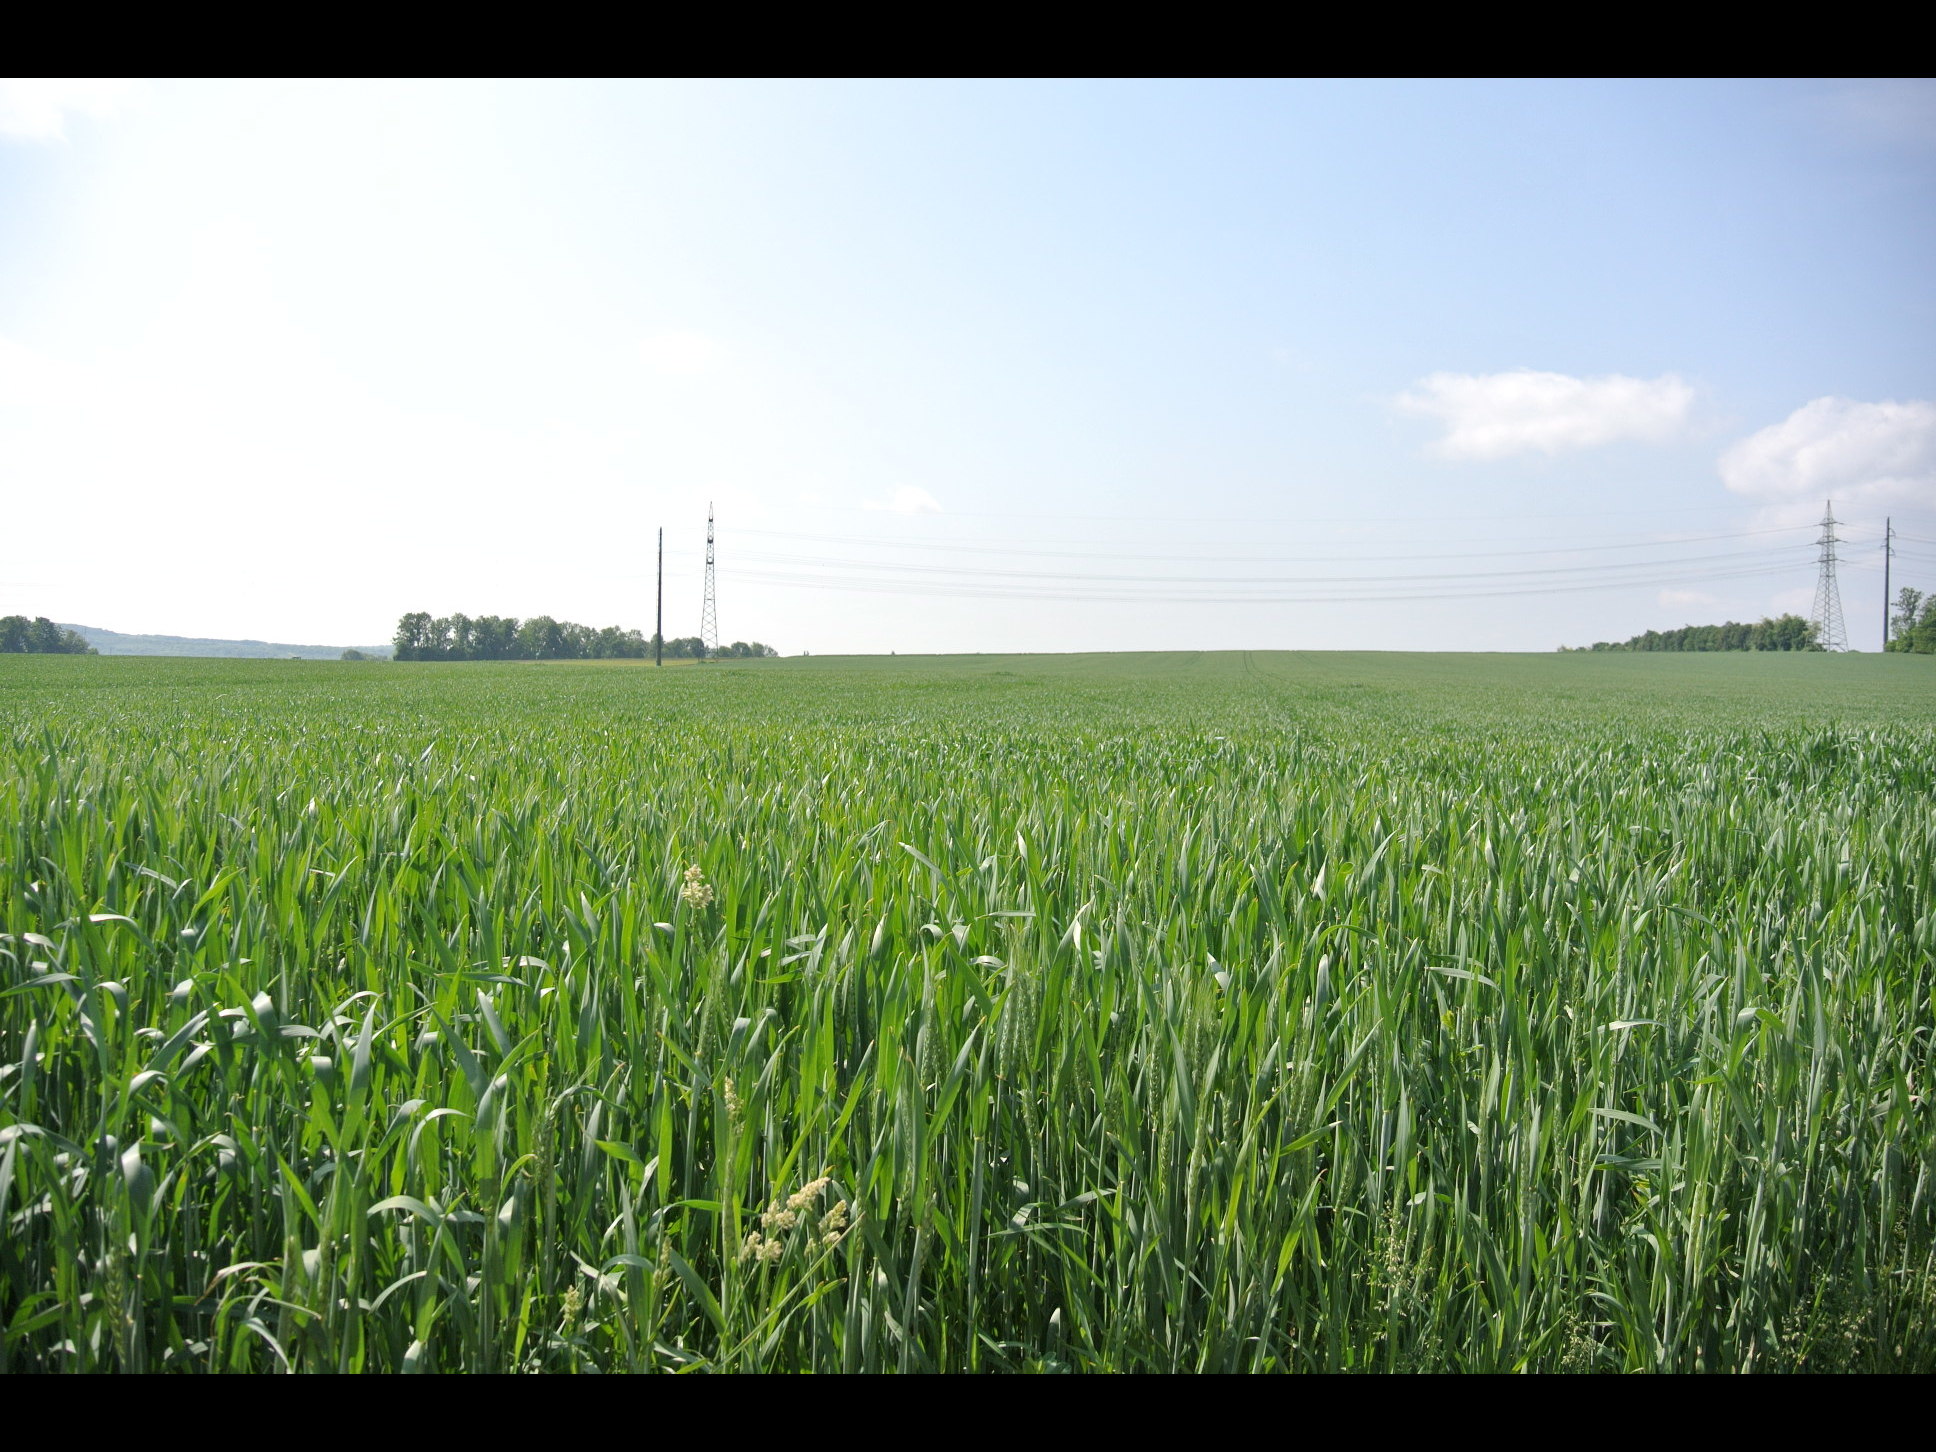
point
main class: Cropland
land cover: Triticale
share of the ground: > 75 %
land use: Agriculture (excluding fallow land and kitchen gardens)
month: May
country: AT
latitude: 48.0345
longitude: 16.7521
